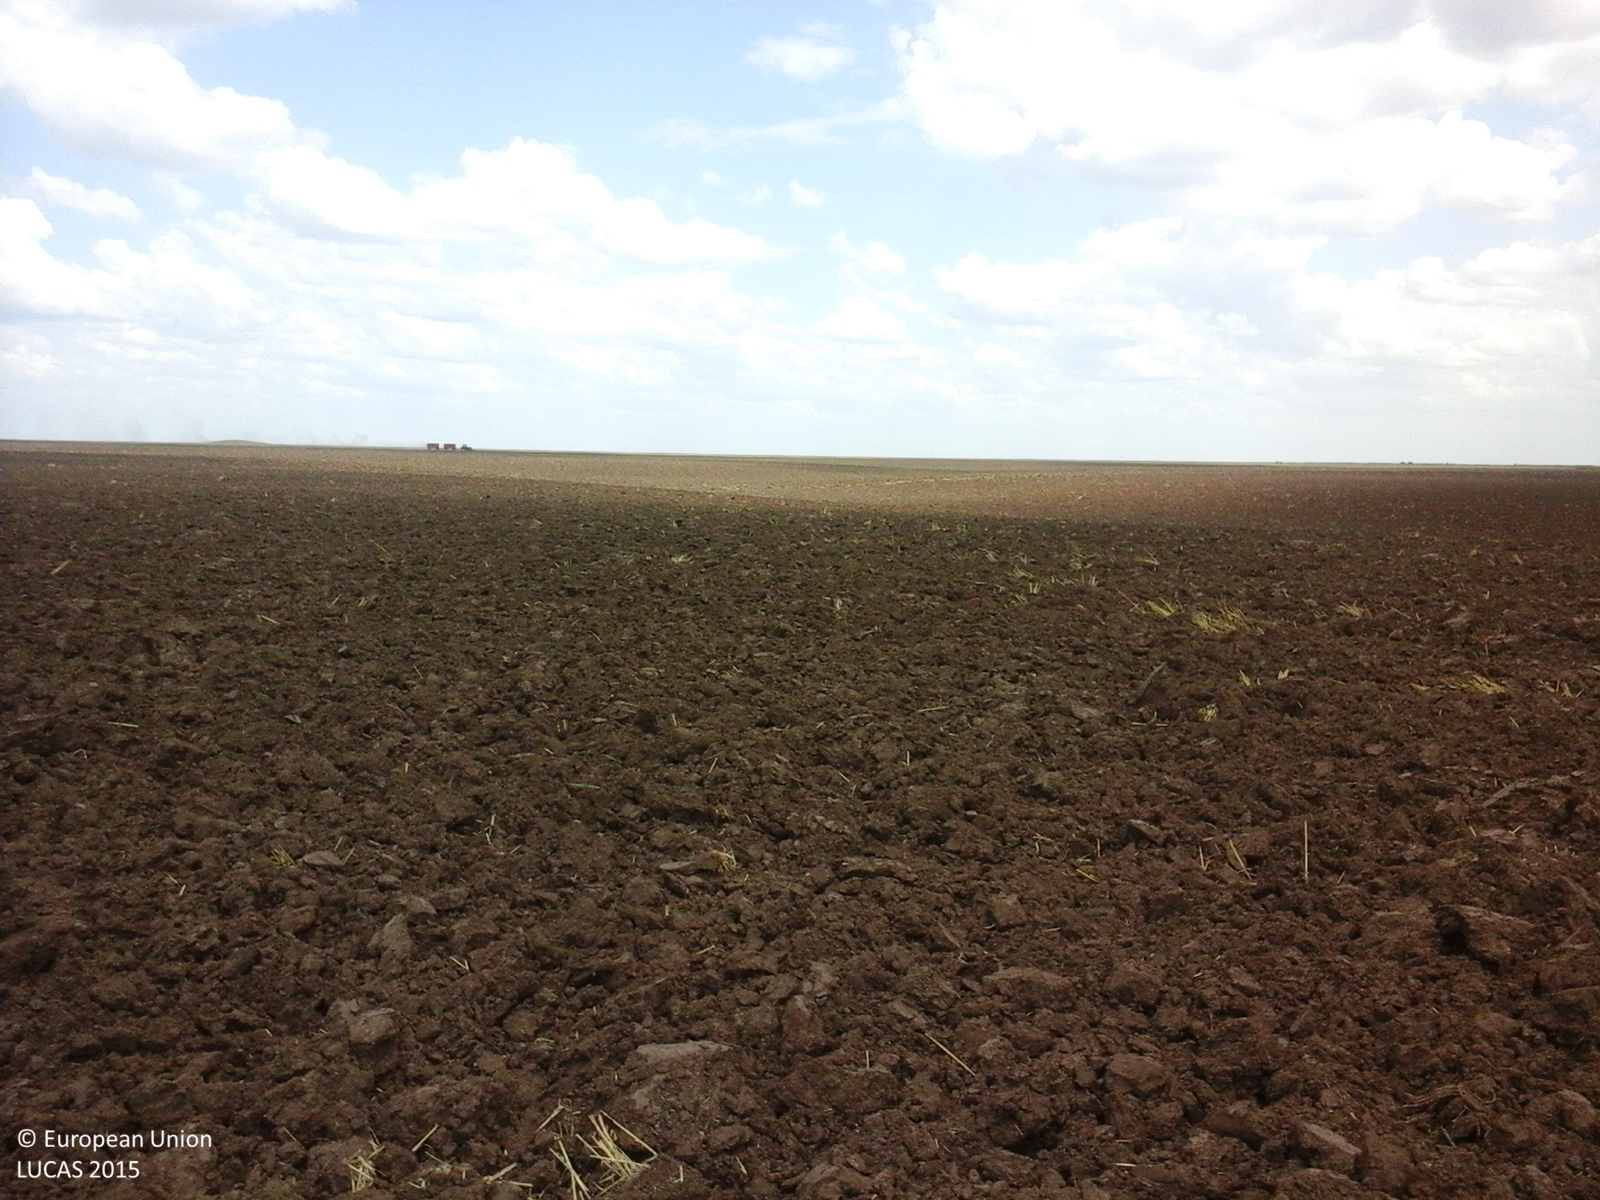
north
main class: Cropland
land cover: Common wheat
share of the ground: < 10 %
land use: Agriculture (excluding fallow land and kitchen gardens)
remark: Harvested field
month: July
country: RO
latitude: 43.9895
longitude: 24.8485
